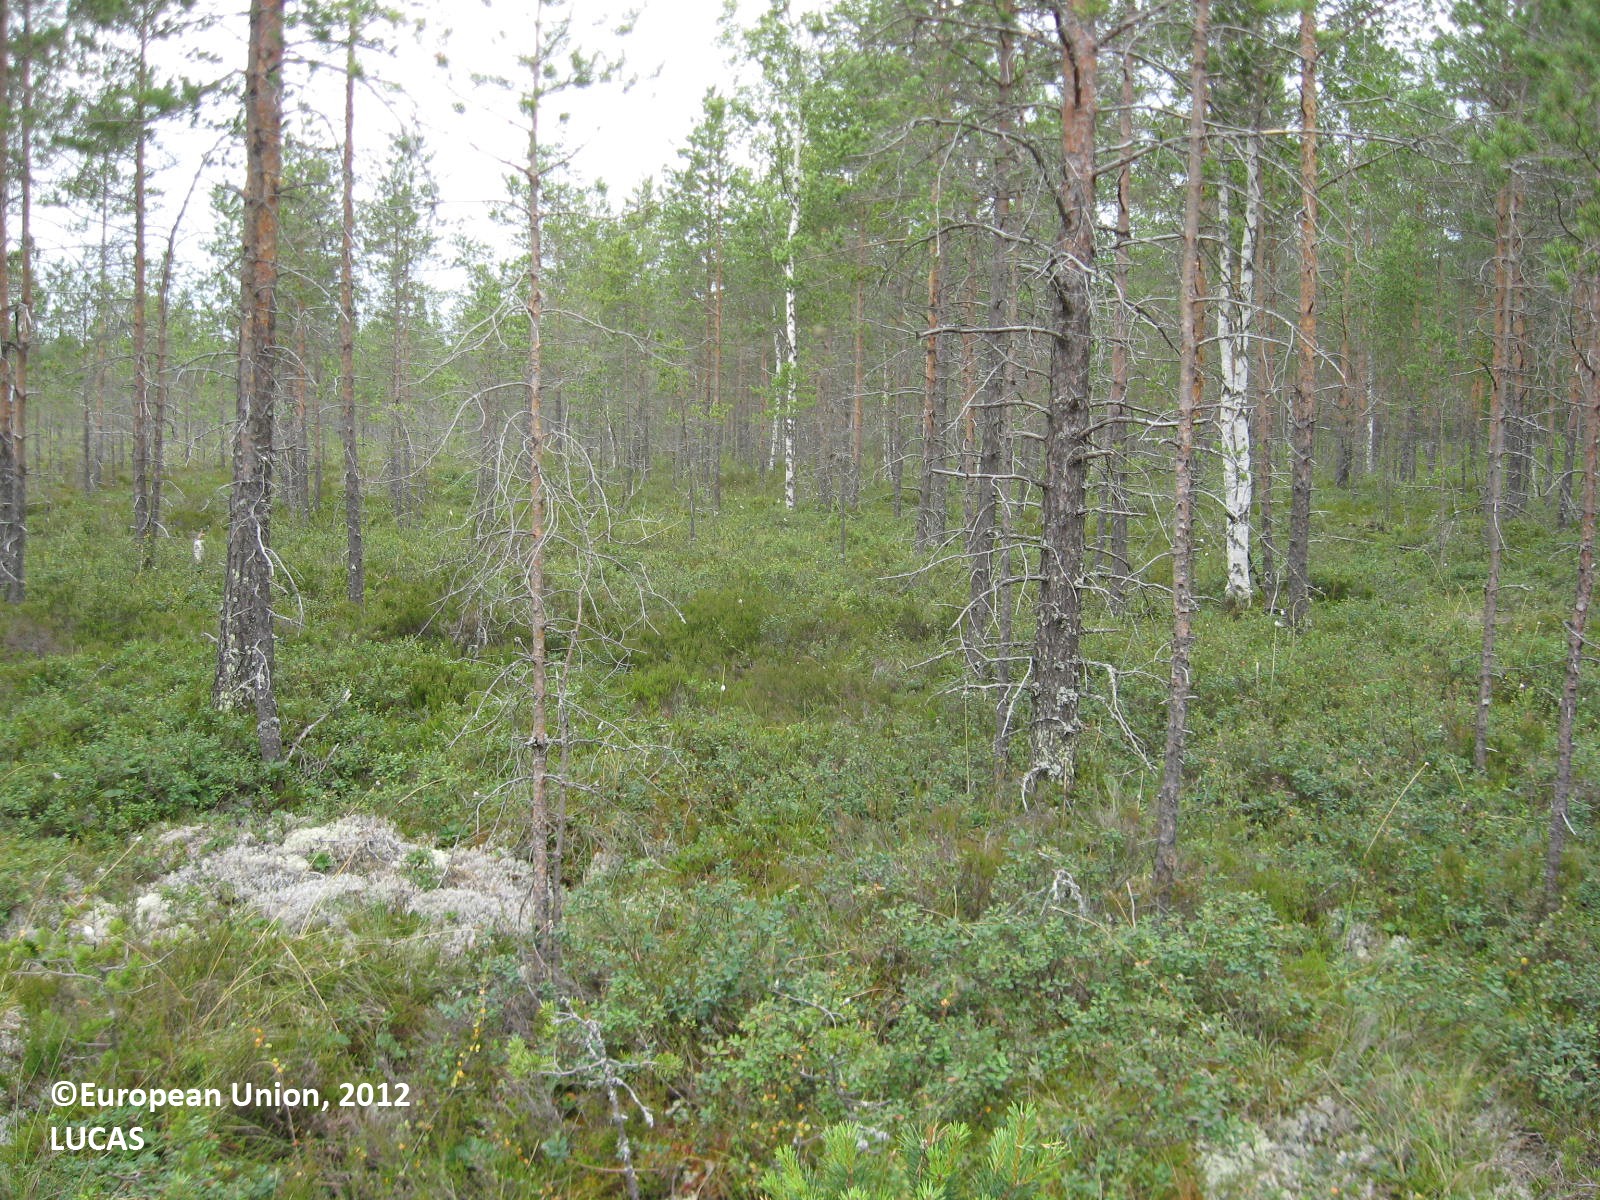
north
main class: Woodland
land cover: Pine dominated coniferous woodland
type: boreal forest
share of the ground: 50 - 75 %
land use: Forestry
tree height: > 5 m
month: July
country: FI
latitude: 62.1593
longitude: 22.7493
